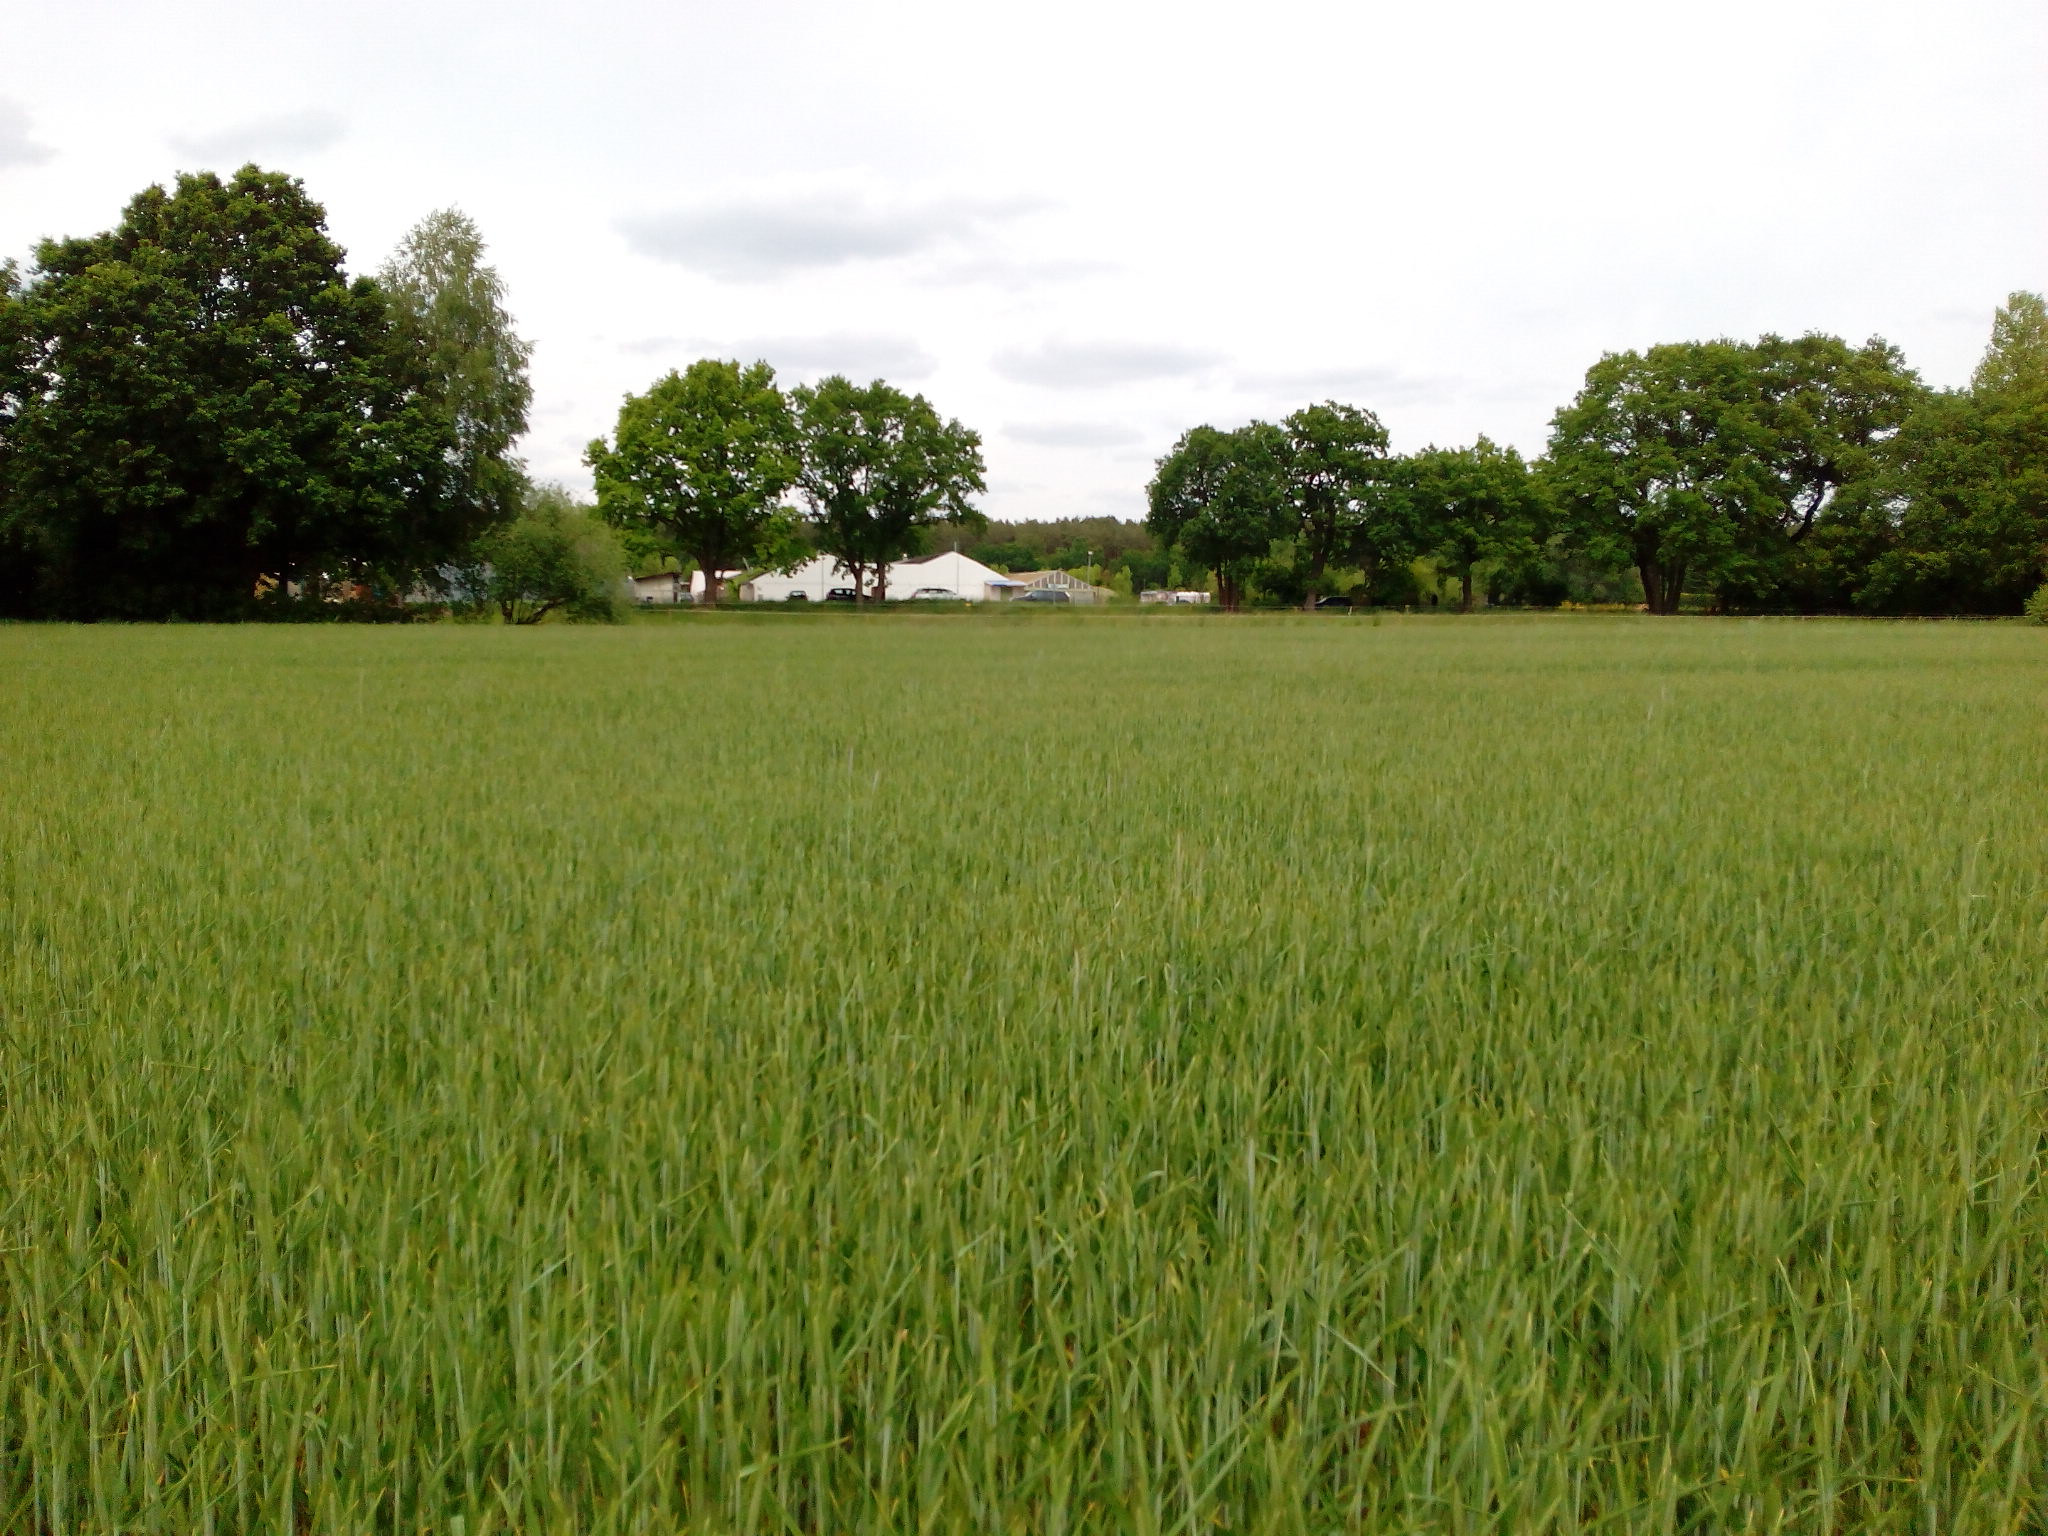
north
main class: Cropland
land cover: Rye
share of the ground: > 75 %
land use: Agriculture (excluding fallow land and kitchen gardens)
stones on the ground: < 10 %
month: June
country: DE
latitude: 52.6830
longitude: 9.8965
